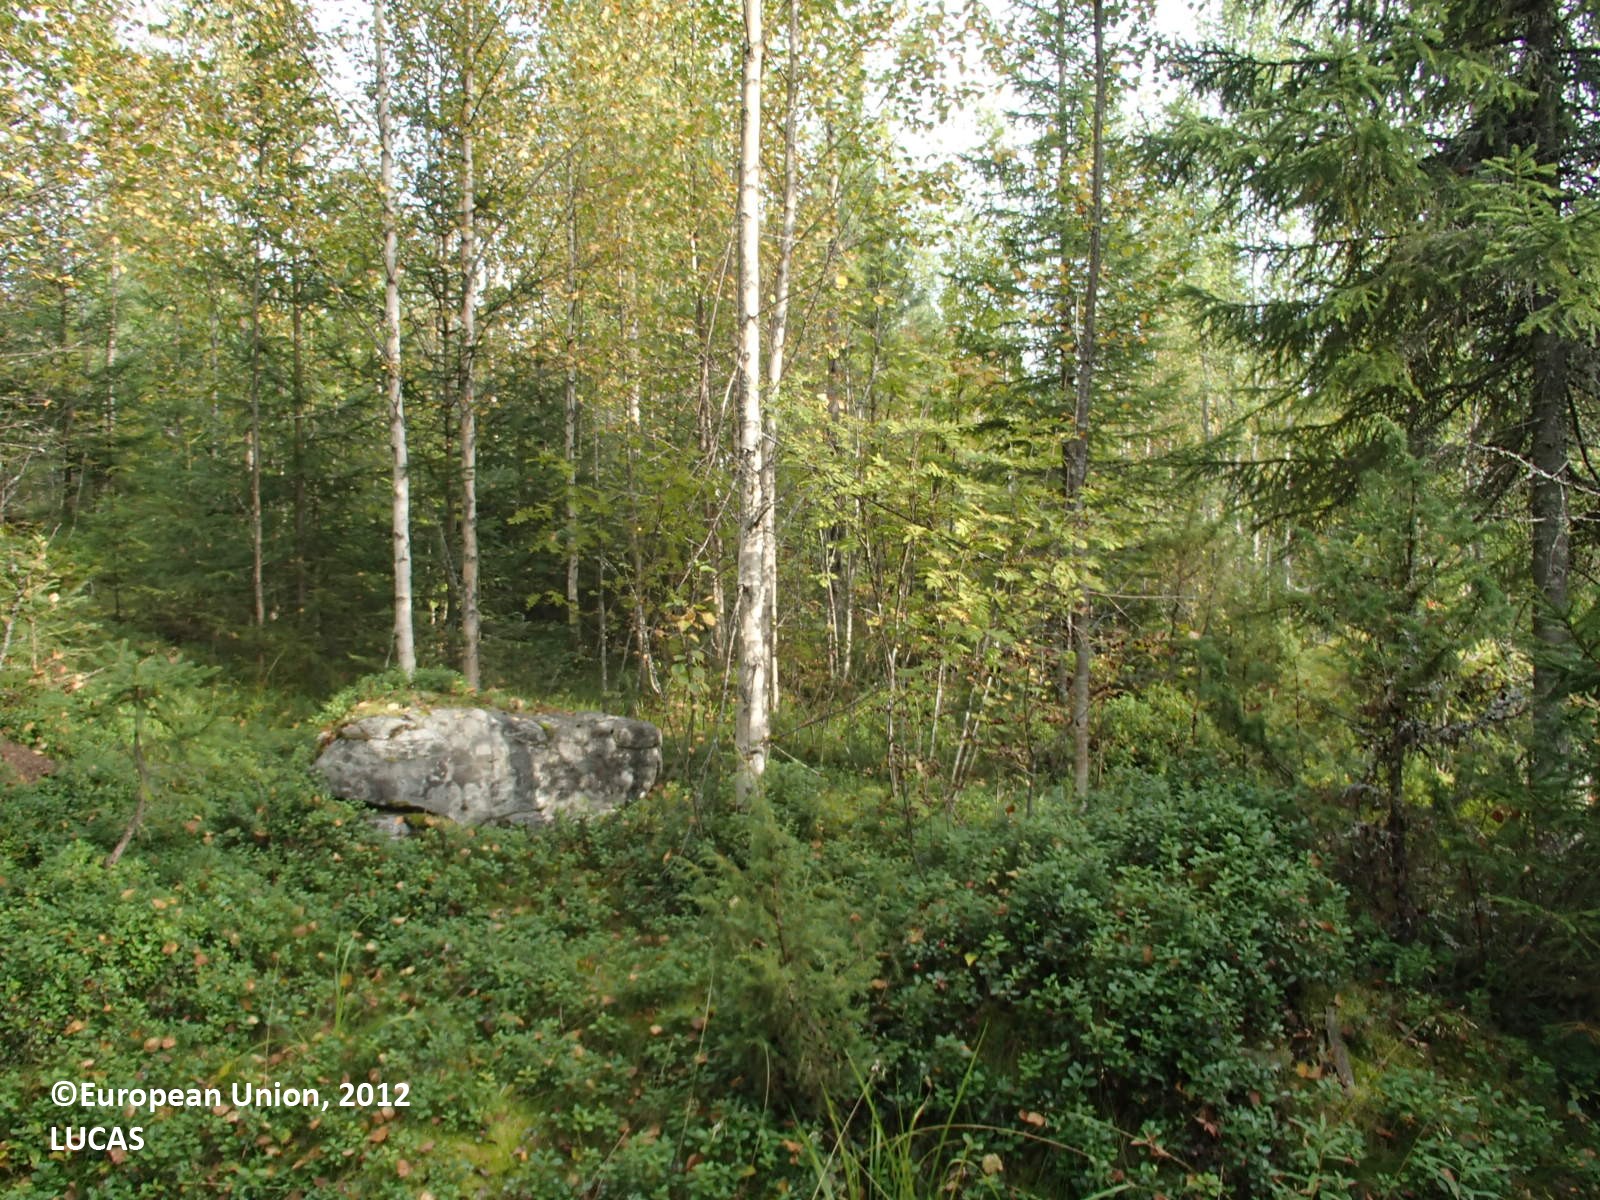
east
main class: Woodland
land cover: Spruce dominated mixed woodland
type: boreal forest
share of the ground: > 75 %
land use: Forestry
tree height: > 5 m
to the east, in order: Spruce dominated mixed woodland
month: August
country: FI
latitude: 63.7380
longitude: 27.0953
